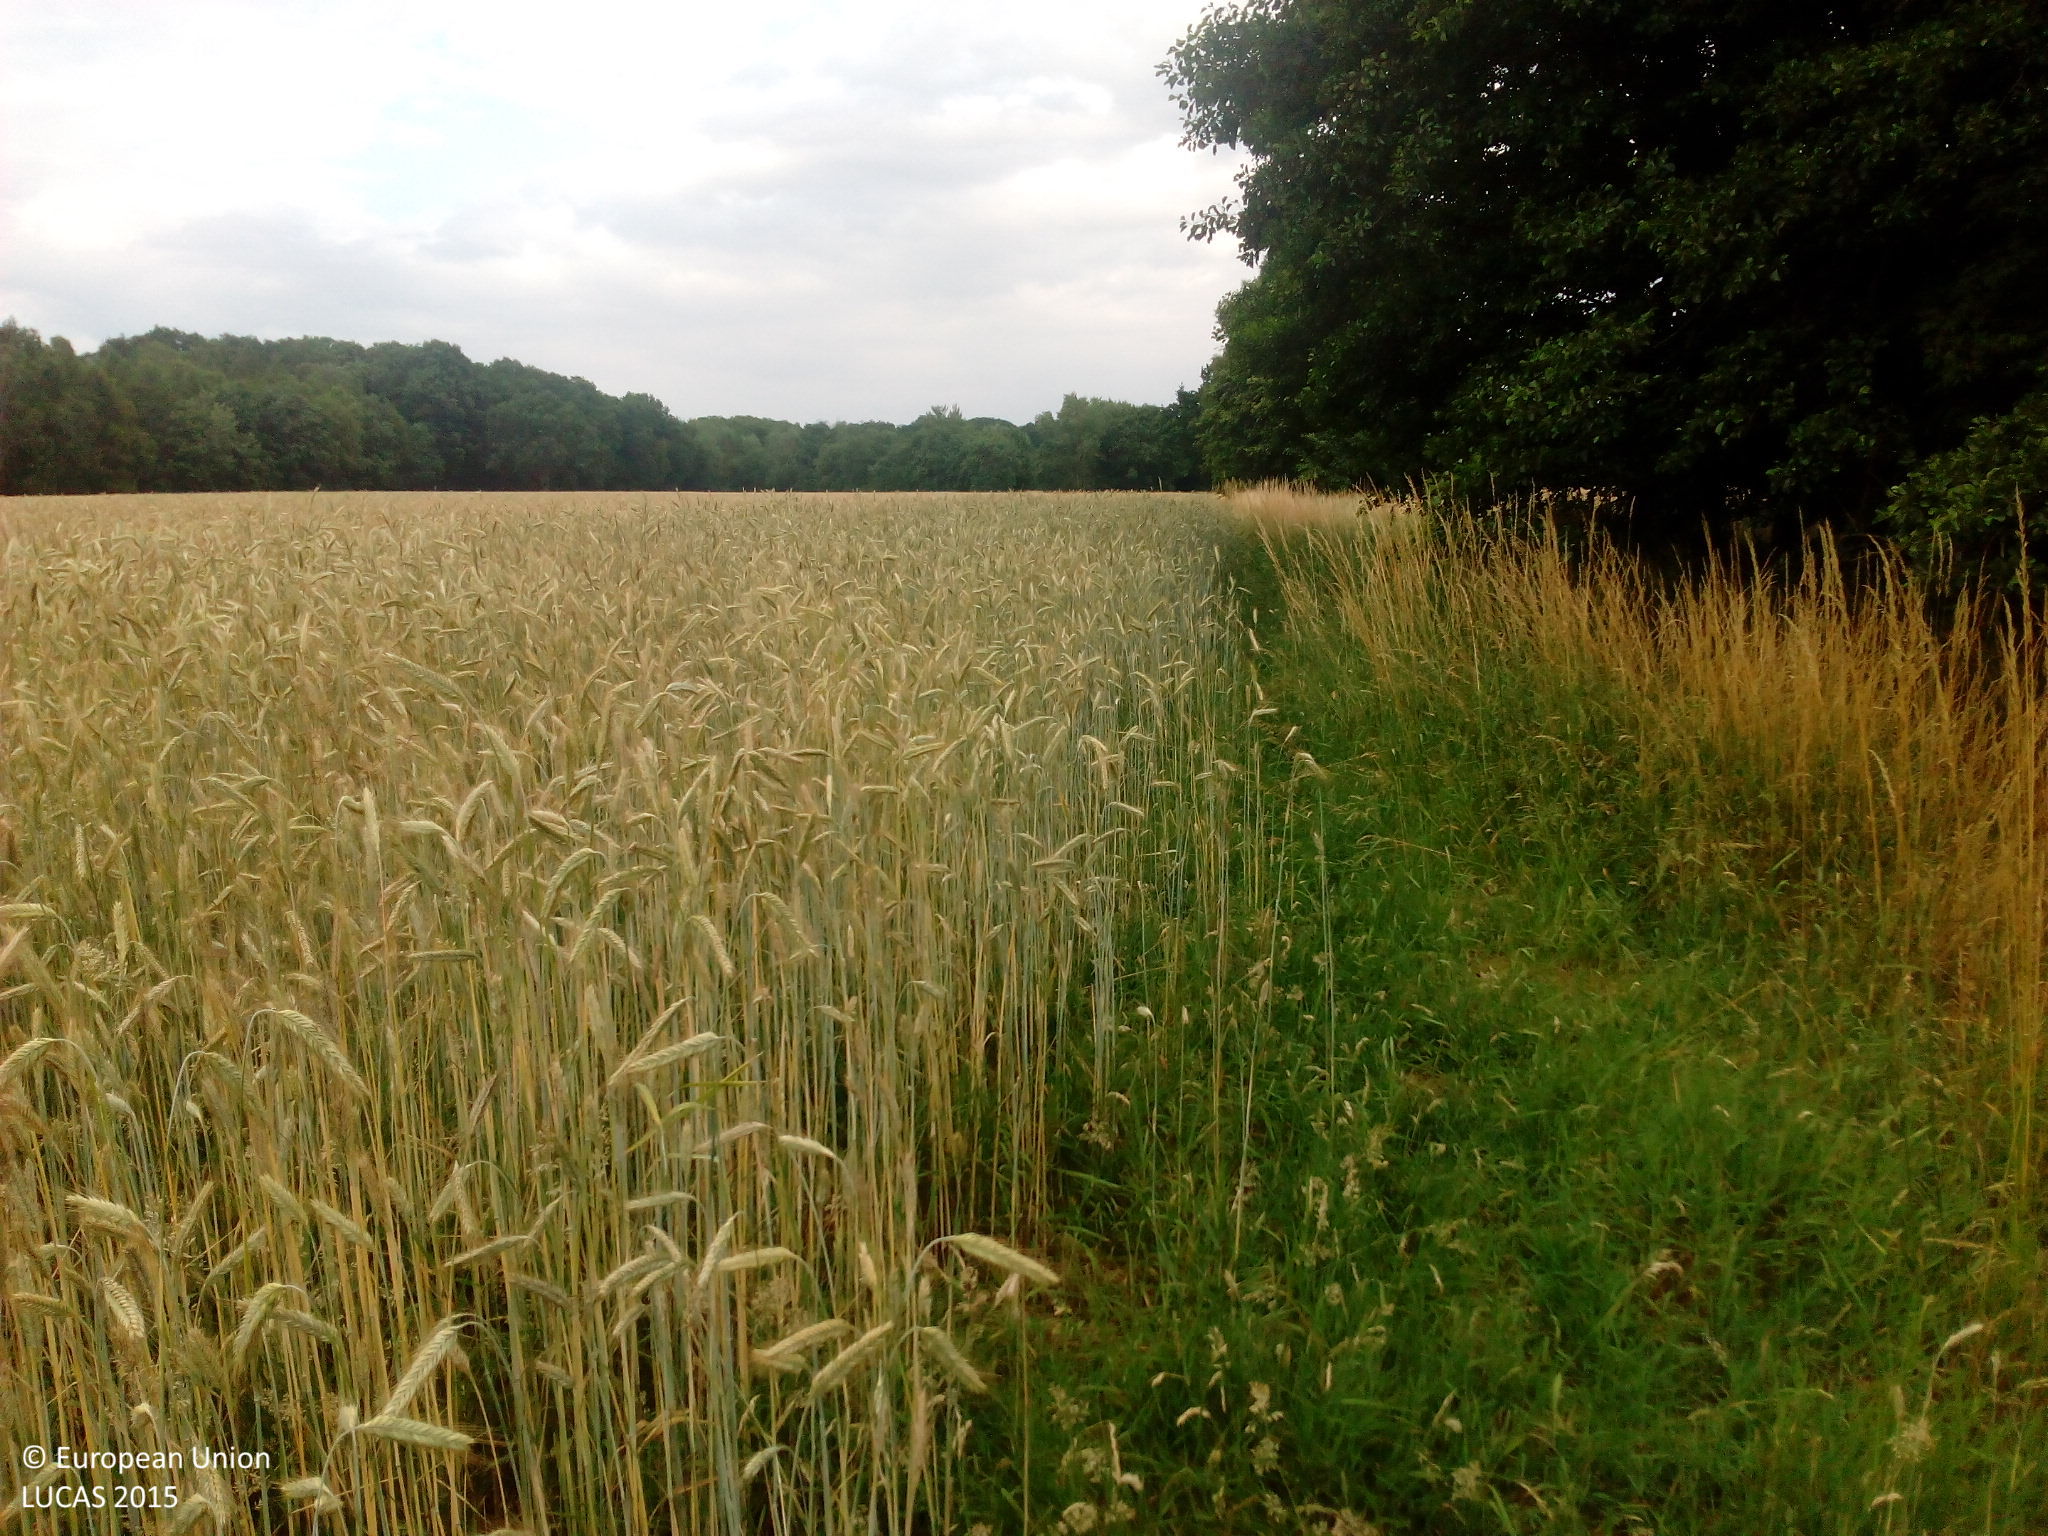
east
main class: Cropland
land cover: Rye
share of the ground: > 75 %
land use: Agriculture (excluding fallow land and kitchen gardens)
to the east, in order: Rye
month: July
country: DE
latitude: 52.8922
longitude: 12.4222
